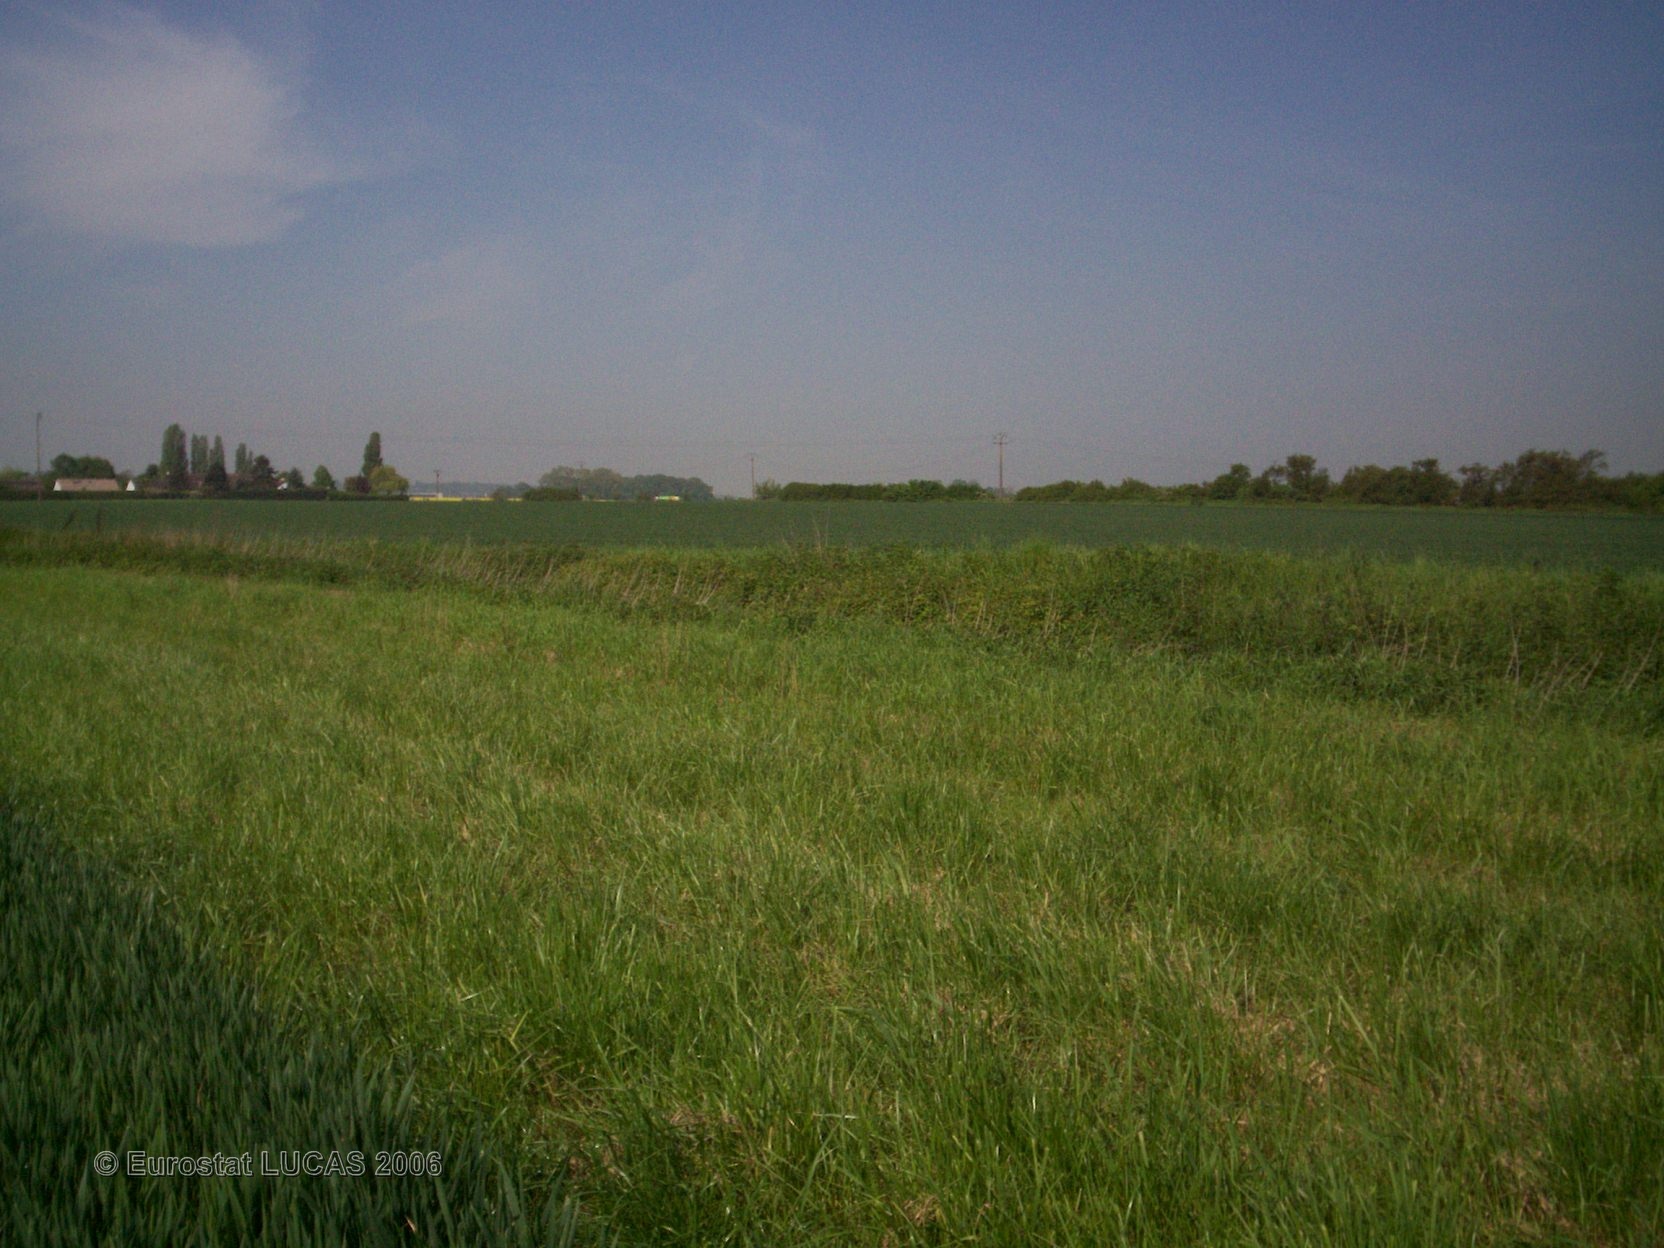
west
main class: Cropland
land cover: Common wheat
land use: Agriculture (excluding fallow land and kitchen gardens)
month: May
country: FR
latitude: 49.0667
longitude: 2.7218
